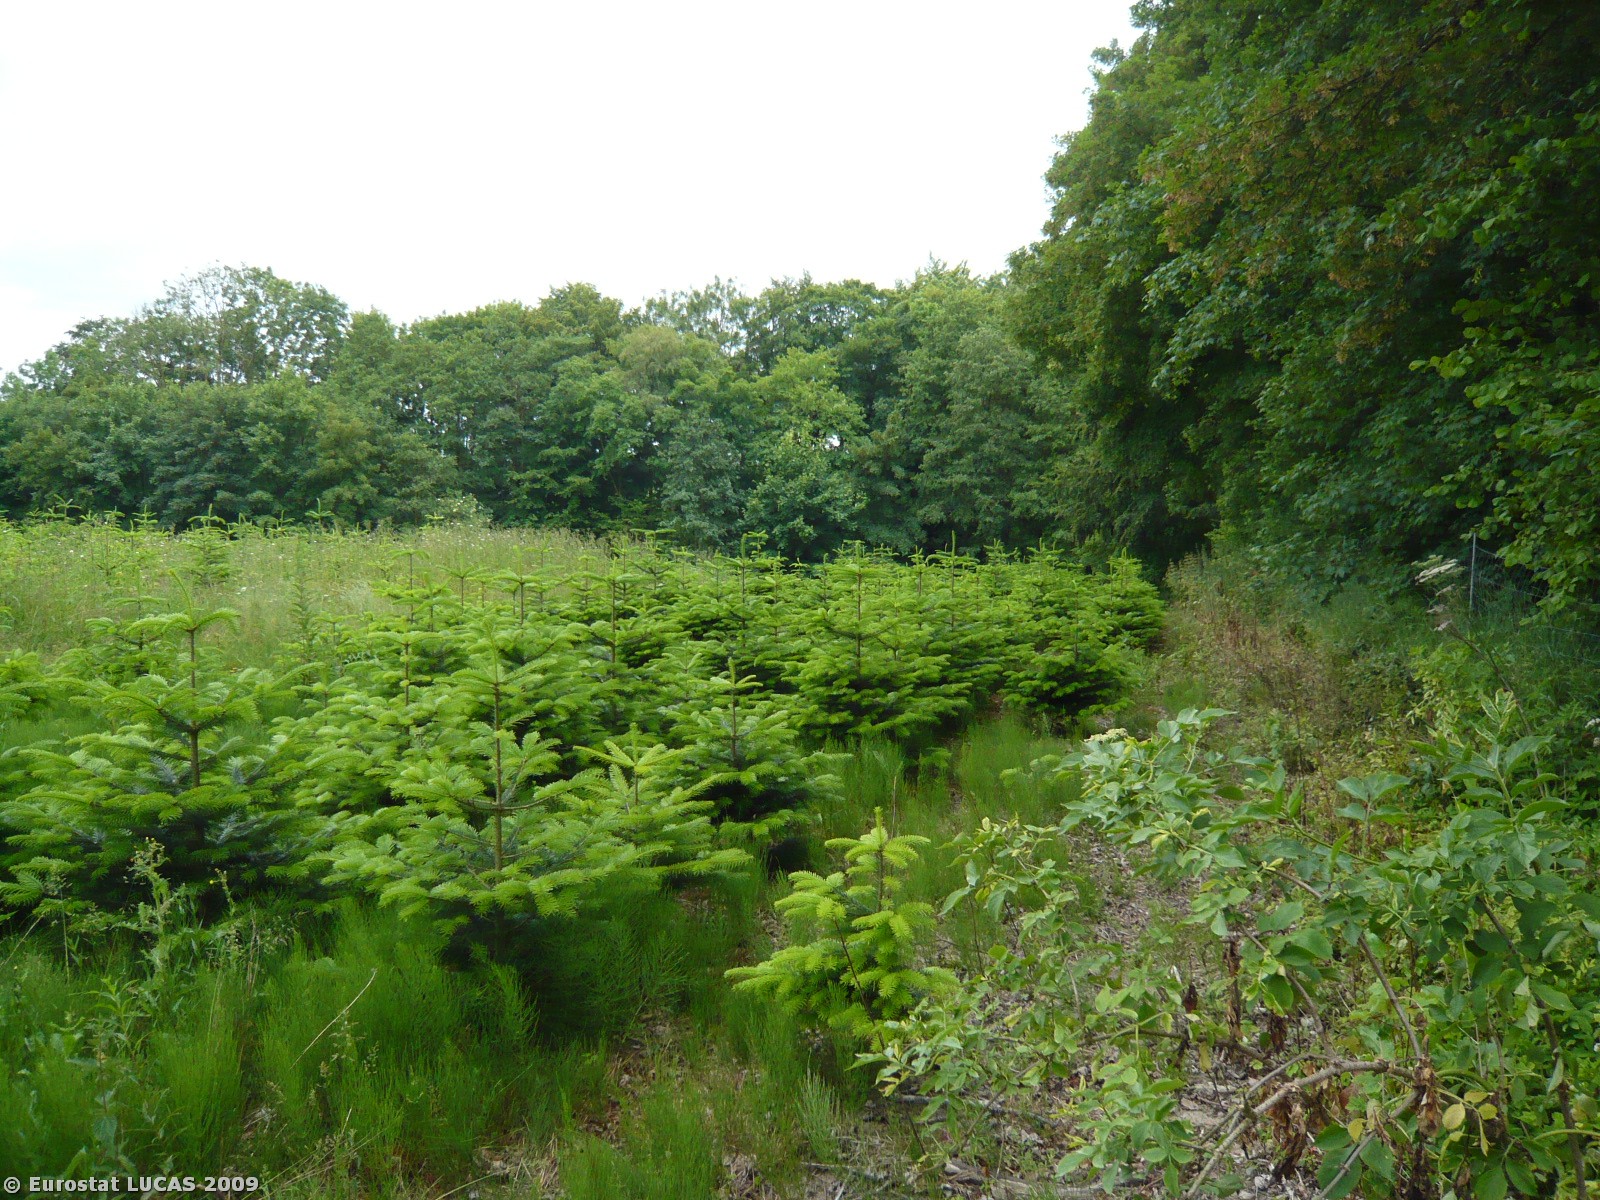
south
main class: Woodland
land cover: Broadleaved woodland
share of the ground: > 75 %
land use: Forestry
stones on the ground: < 10 %
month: June
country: DK
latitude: 55.1616
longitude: 10.6430
